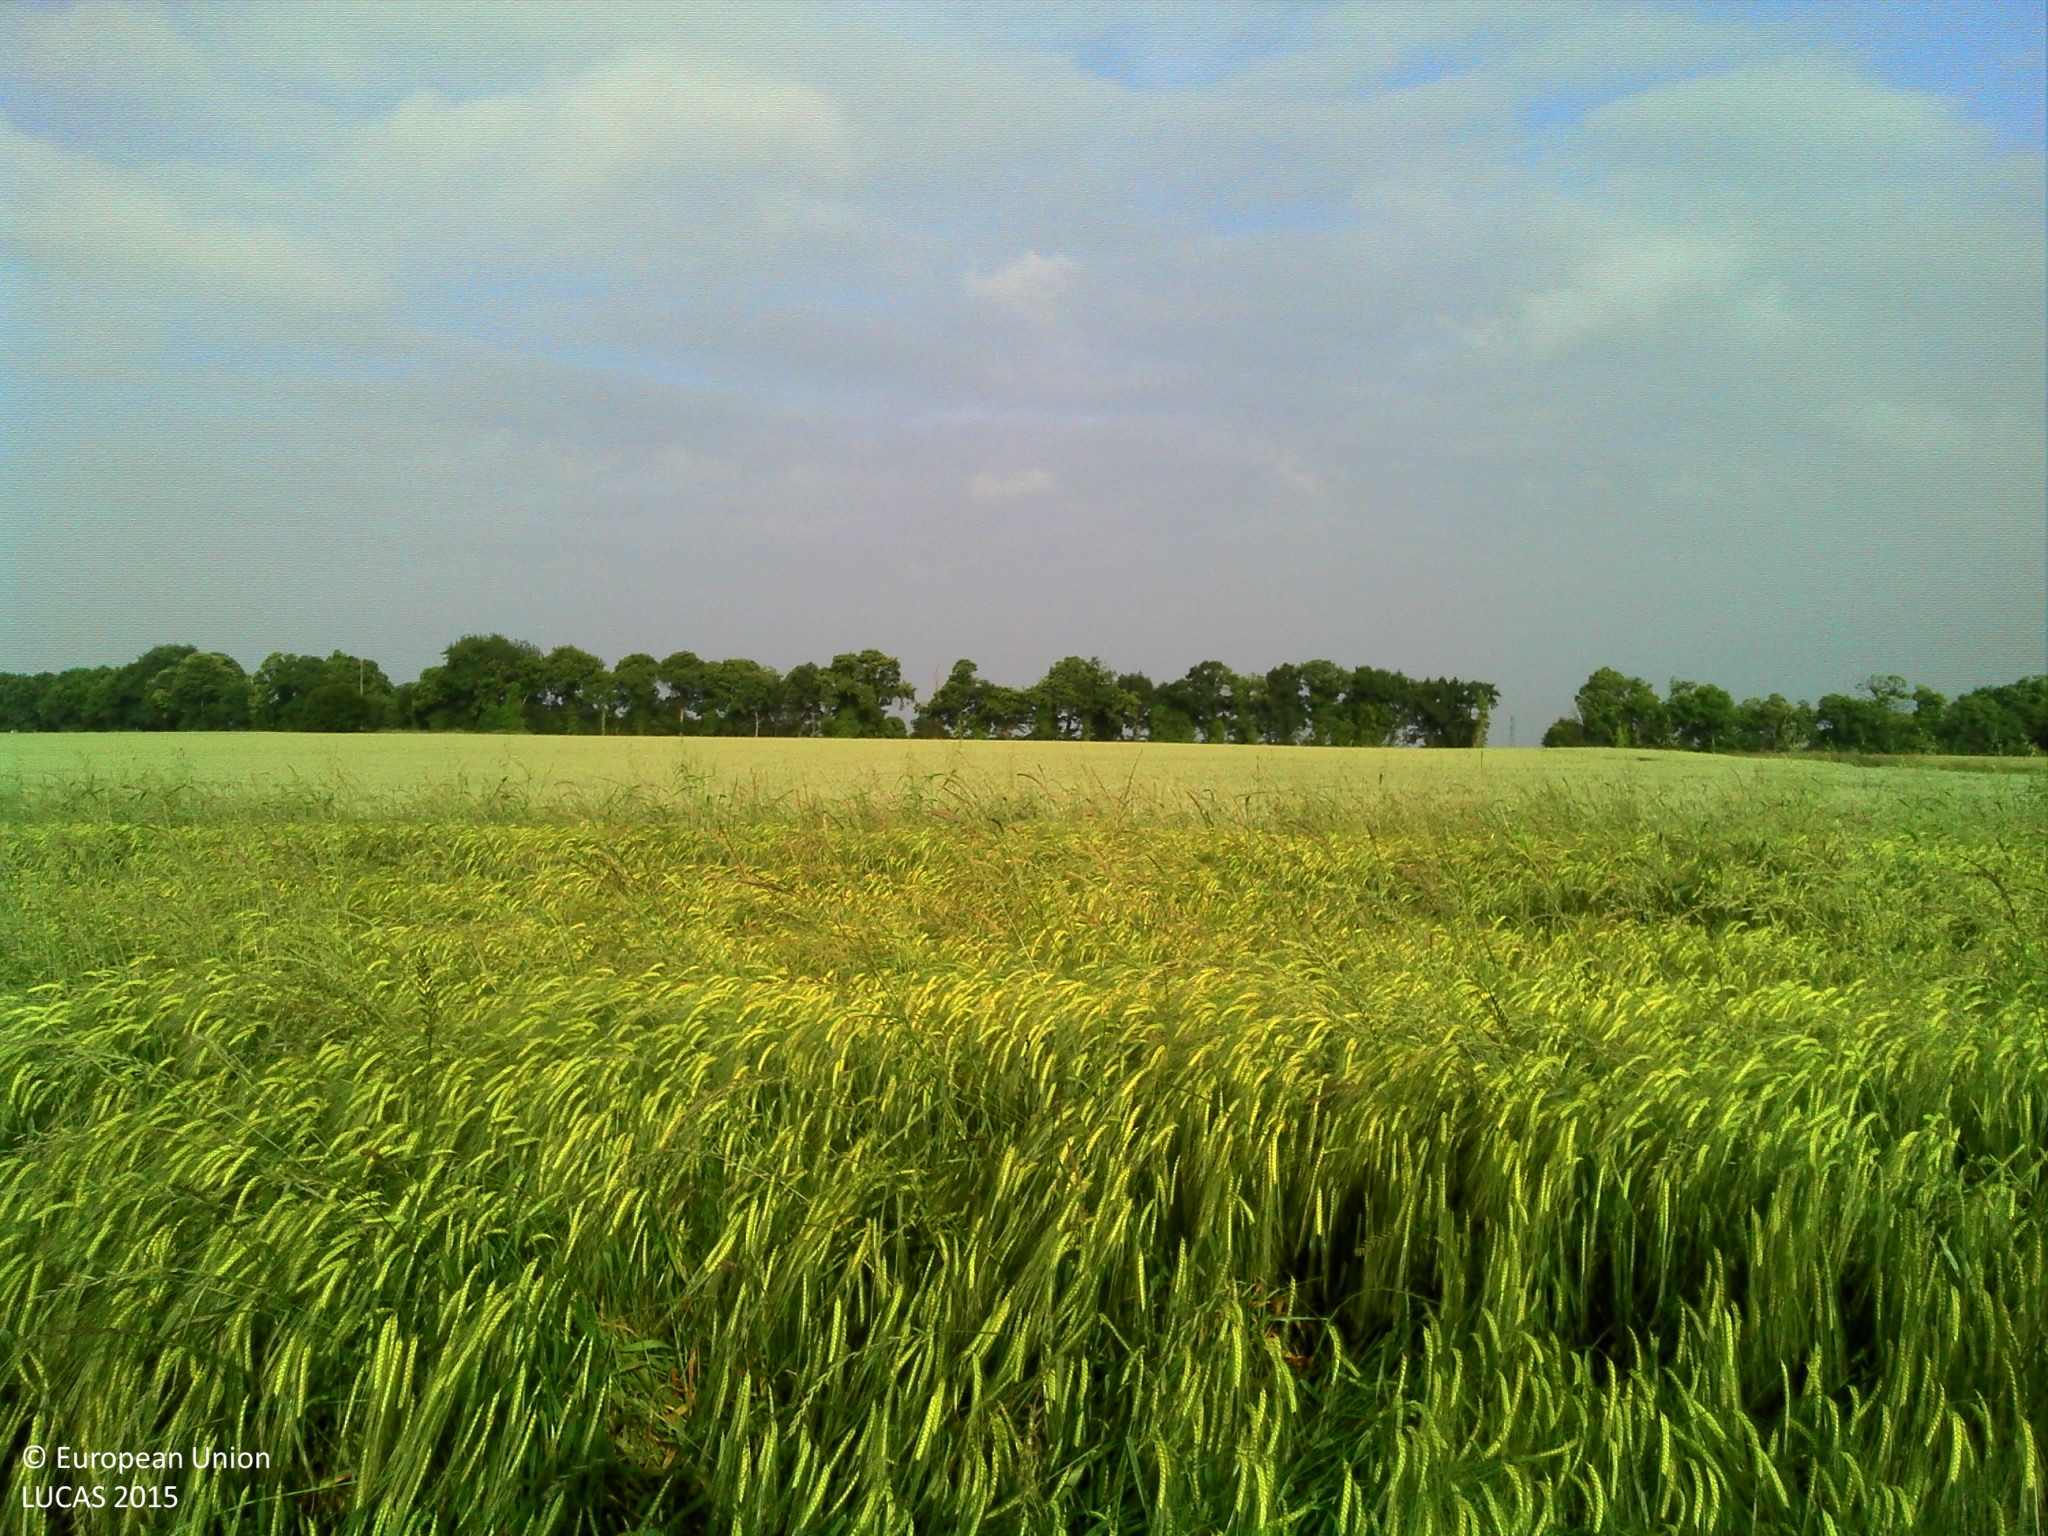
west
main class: Cropland
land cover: Barley
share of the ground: > 75 %
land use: Agriculture (excluding fallow land and kitchen gardens)
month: June
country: FR
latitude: 48.4151
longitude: -1.7098
